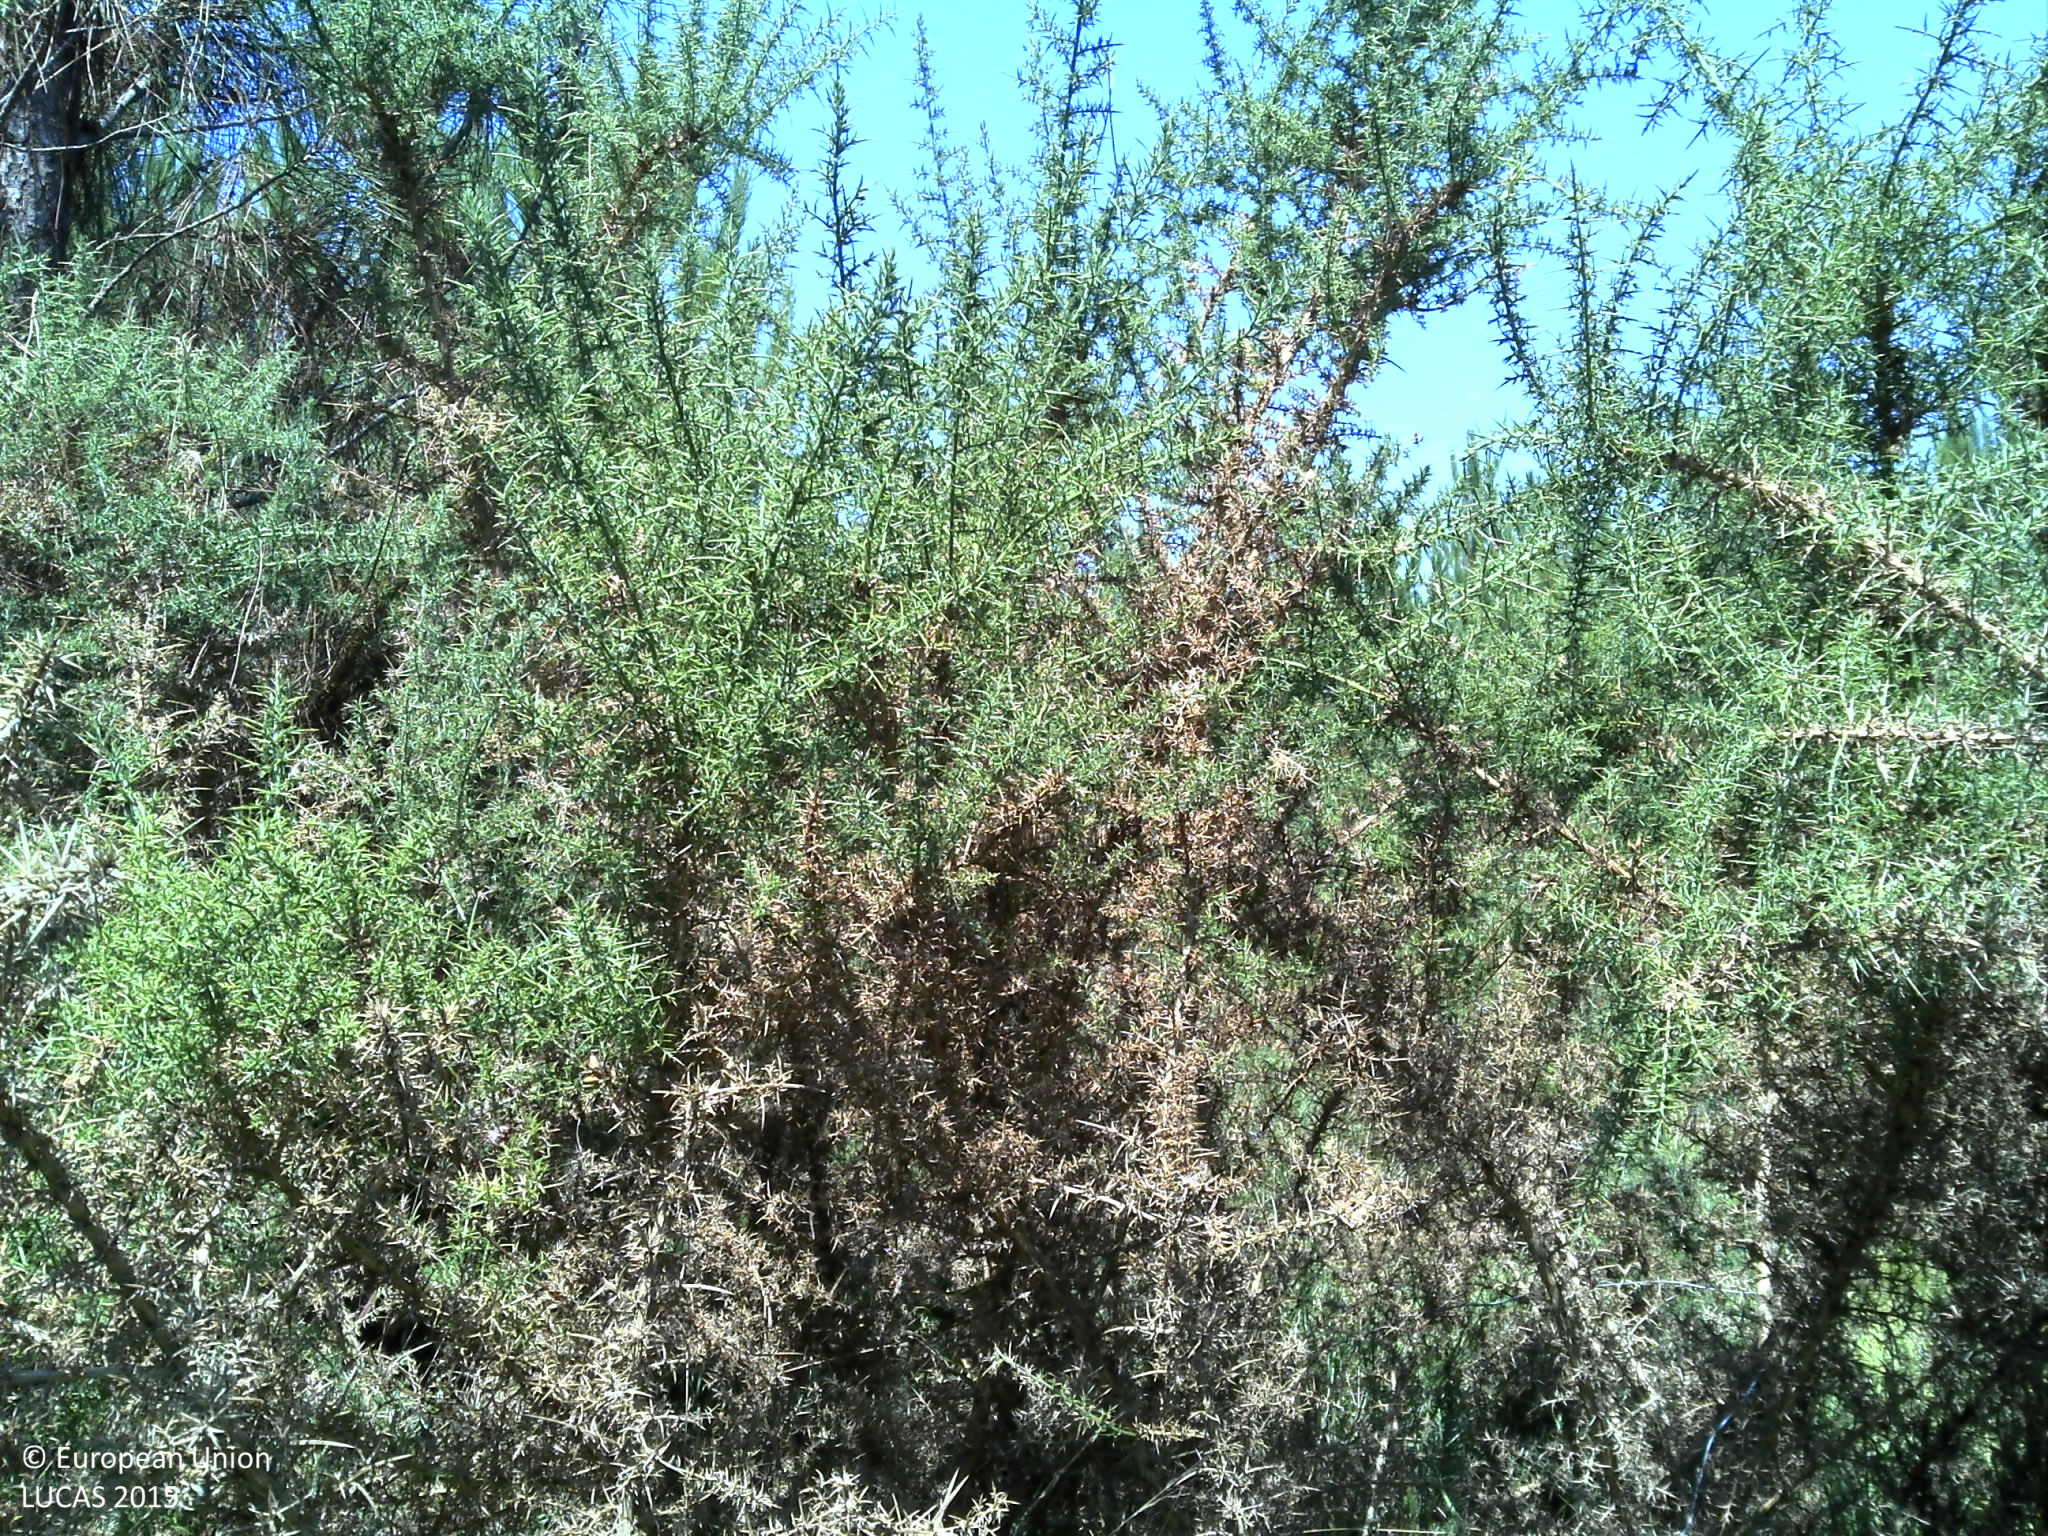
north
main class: Woodland
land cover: Pine dominated coniferous woodland
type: coniferous forest of the mediterranean region
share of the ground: > 75 %
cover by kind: shrubs 60 %, coniferous forest trees 40 %
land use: Forestry
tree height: < 5 m
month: August
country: FR
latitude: 45.0270
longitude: -0.7459
